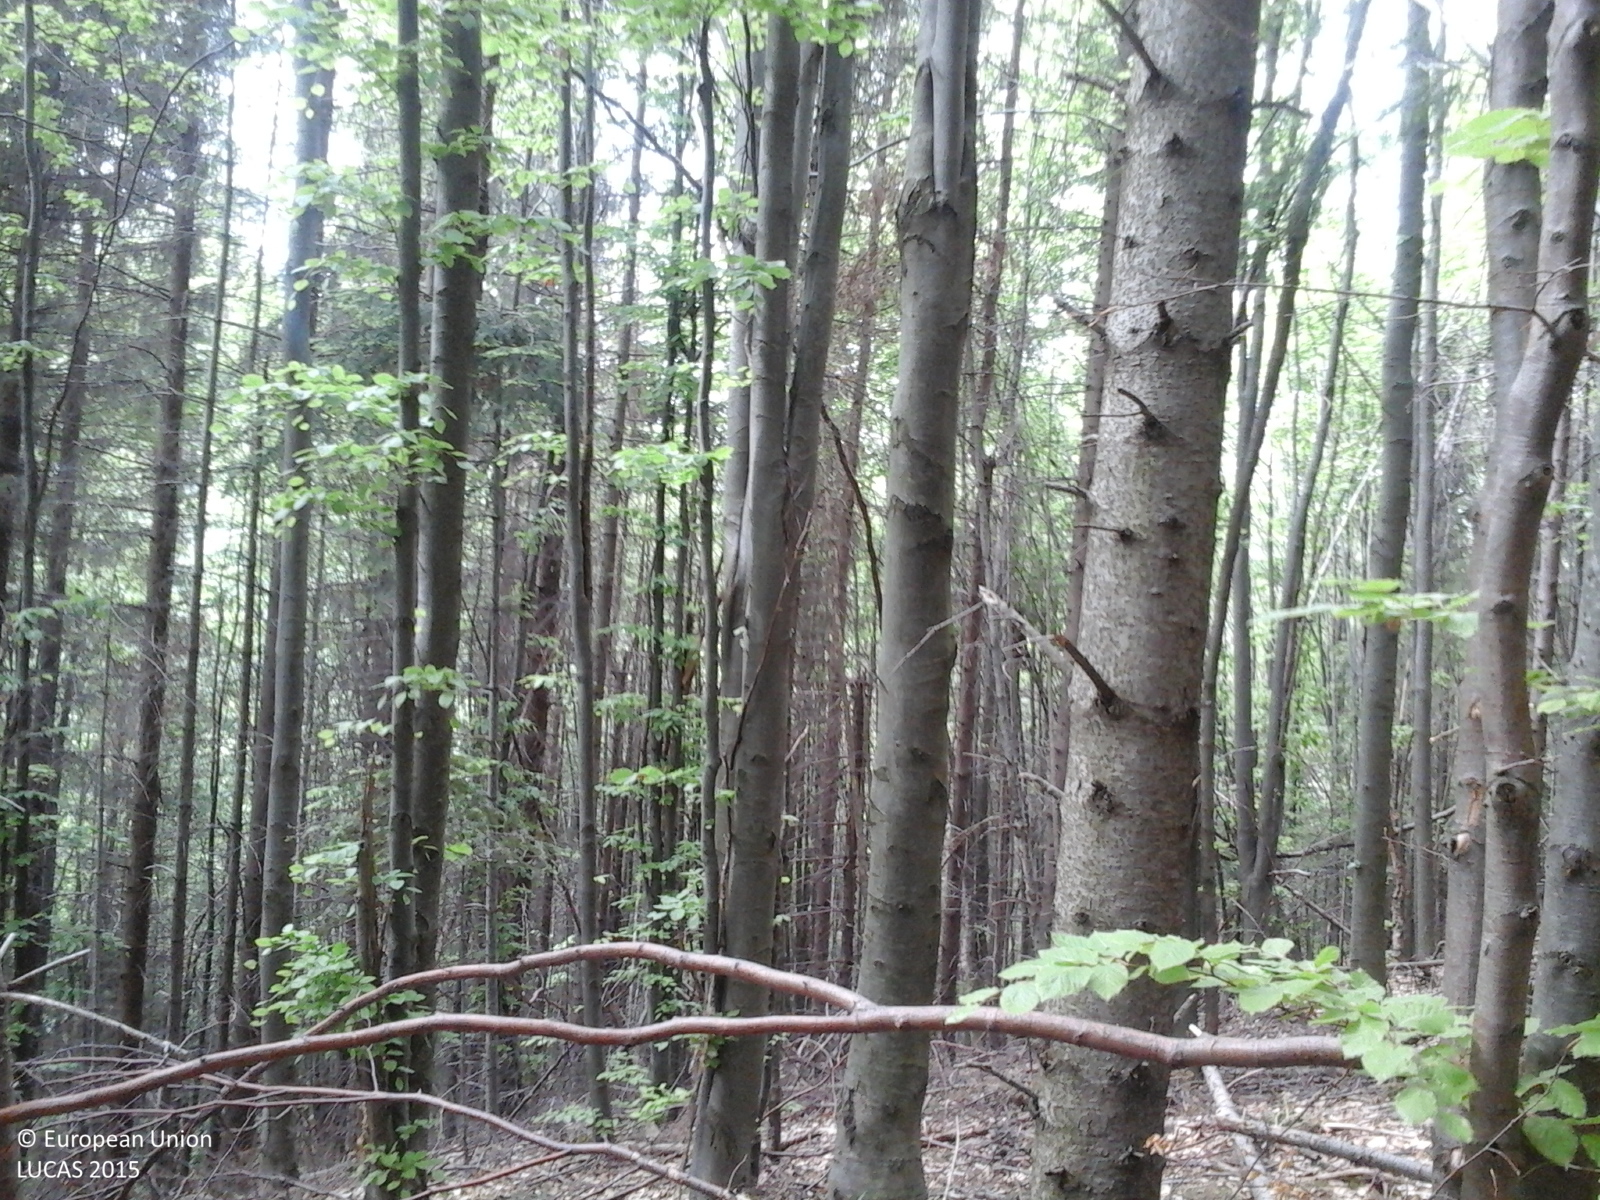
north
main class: Woodland
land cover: Other mixed woodland
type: mountainous beech forest
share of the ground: > 75 %
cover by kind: coniferous forest trees 60 %, broadleaved forest trees 40 %
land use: Forestry
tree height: > 5 m
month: May
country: RO
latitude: 46.0965
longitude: 26.4401
